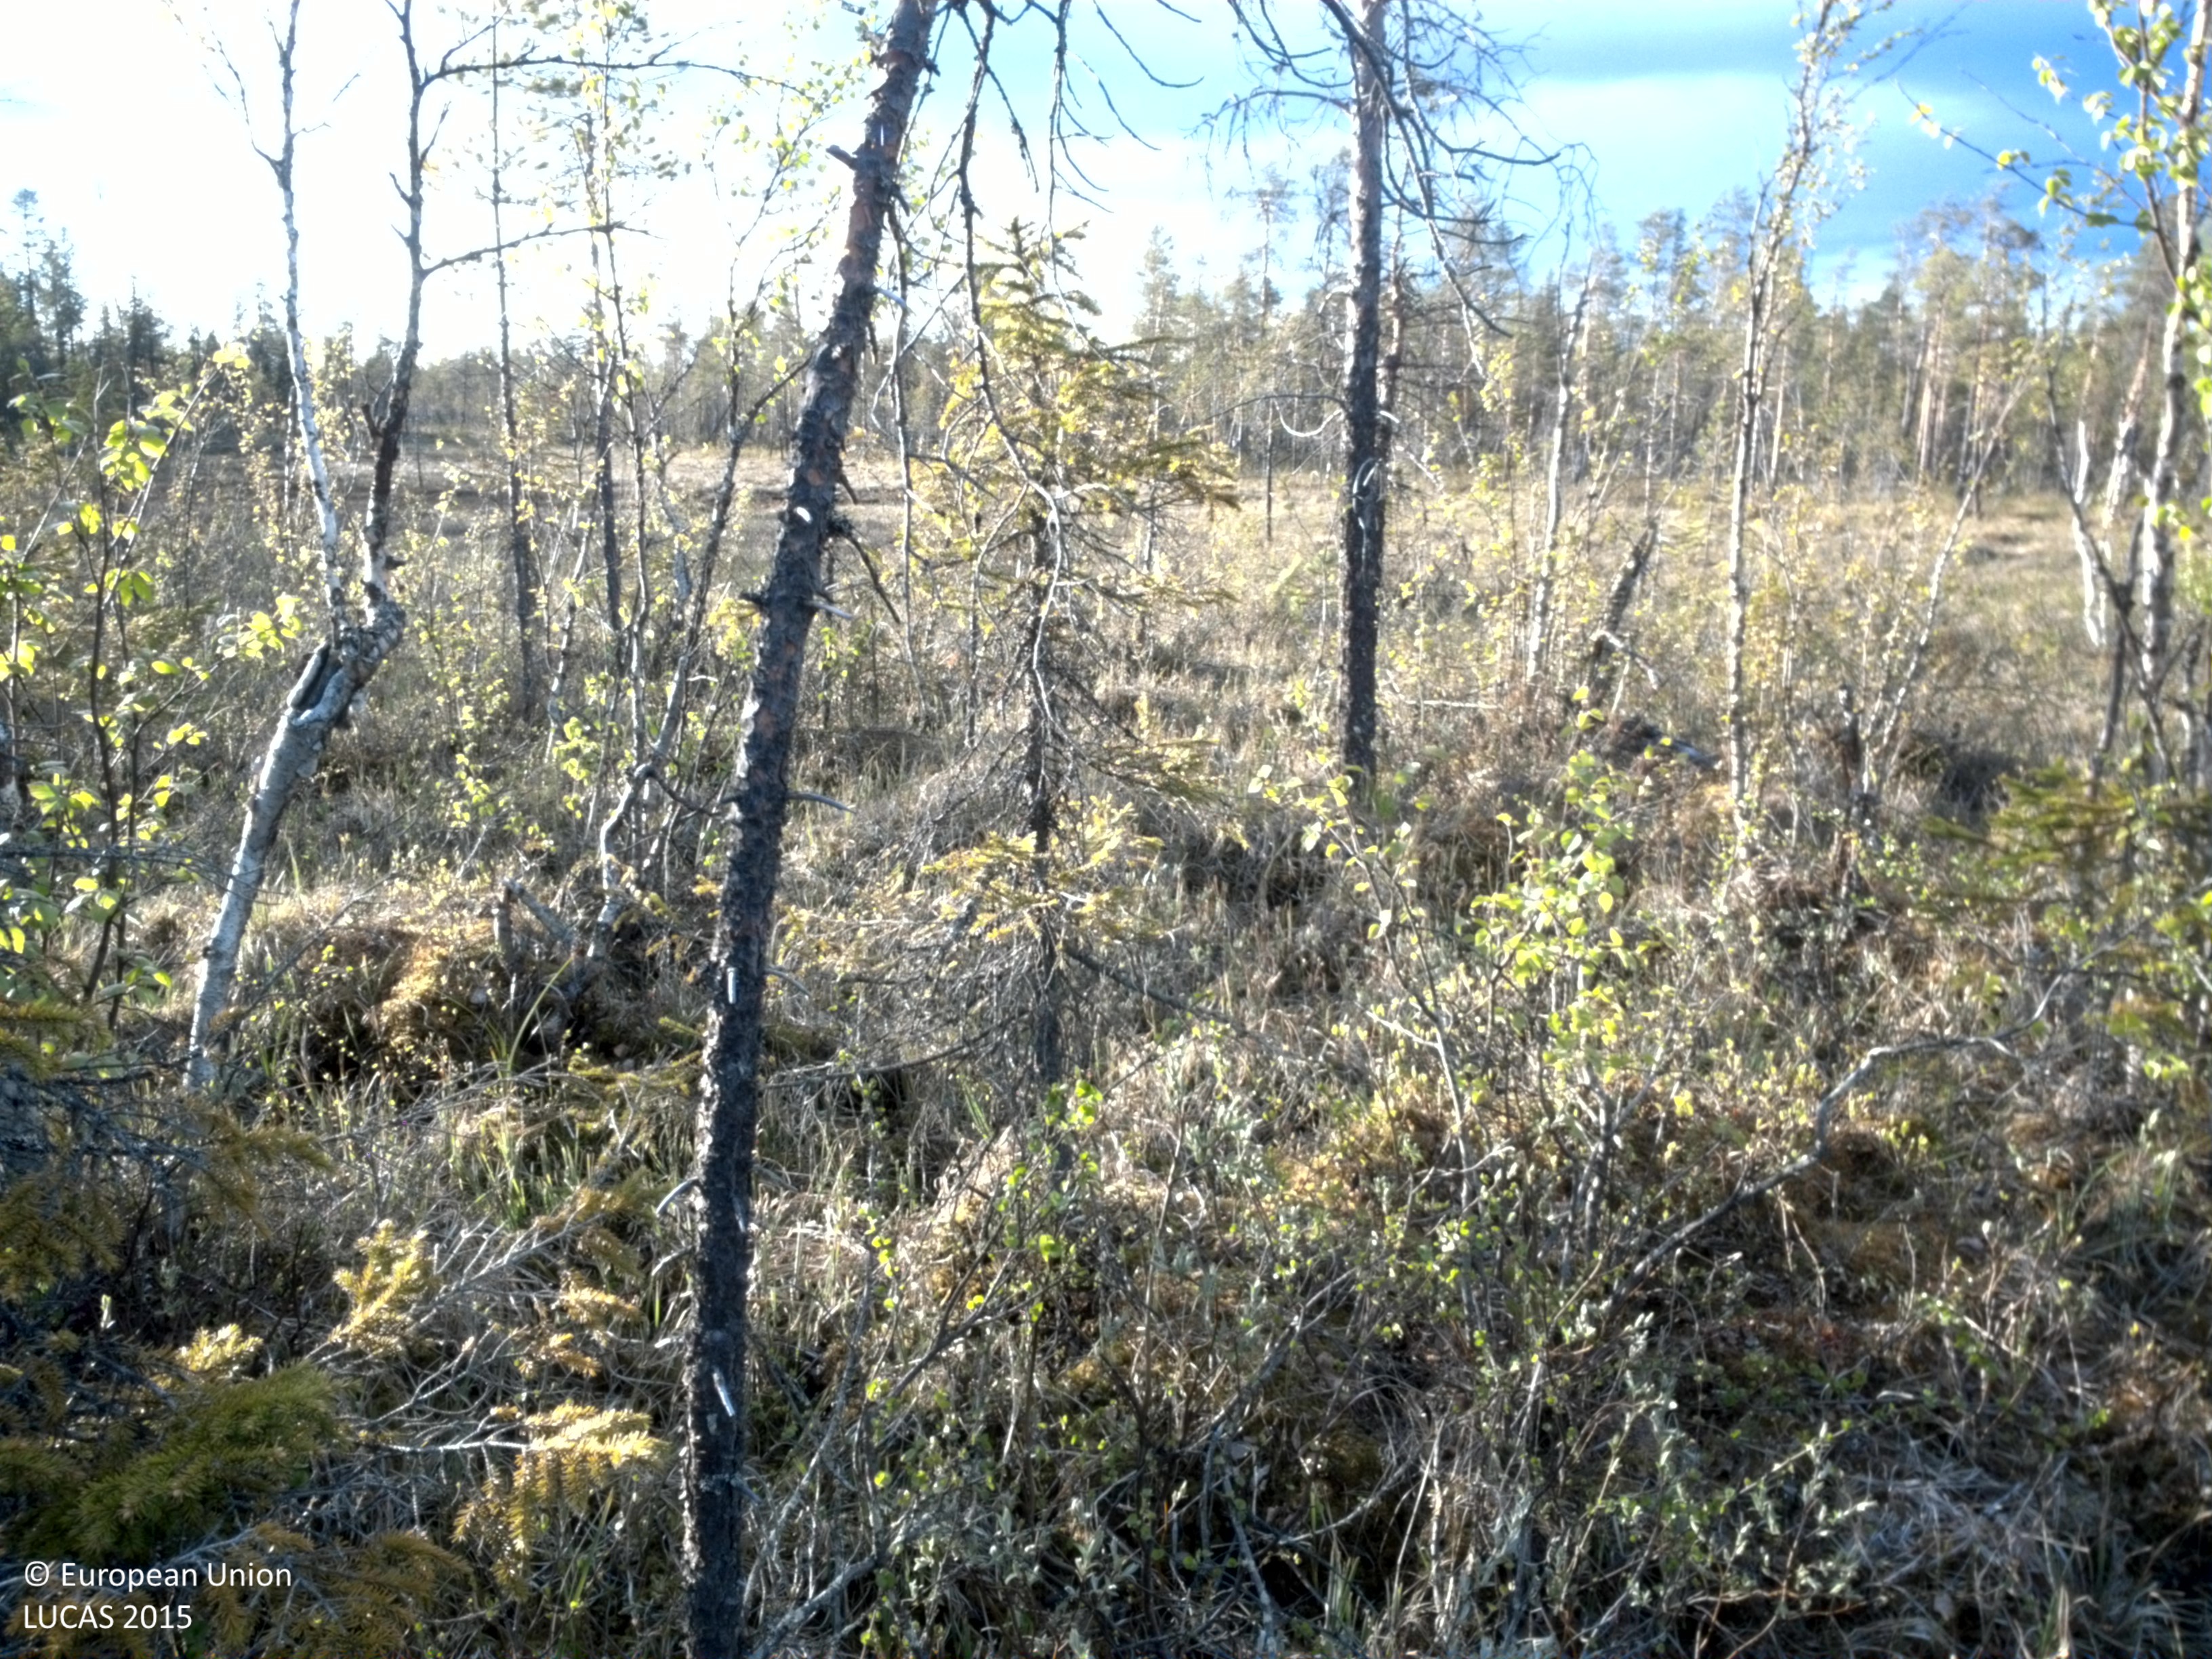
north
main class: Woodland
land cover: Pine dominated mixed woodland
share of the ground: 10 - 25 %
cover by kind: shrubs 50 %, herbaceous plants 20 %, coniferous forest trees 15 %, lichens and mosses 10 %, broadleaved forest trees 5 %
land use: Semi-natural and natural areas not in use
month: June
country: SE
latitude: 66.8826
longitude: 21.6220
